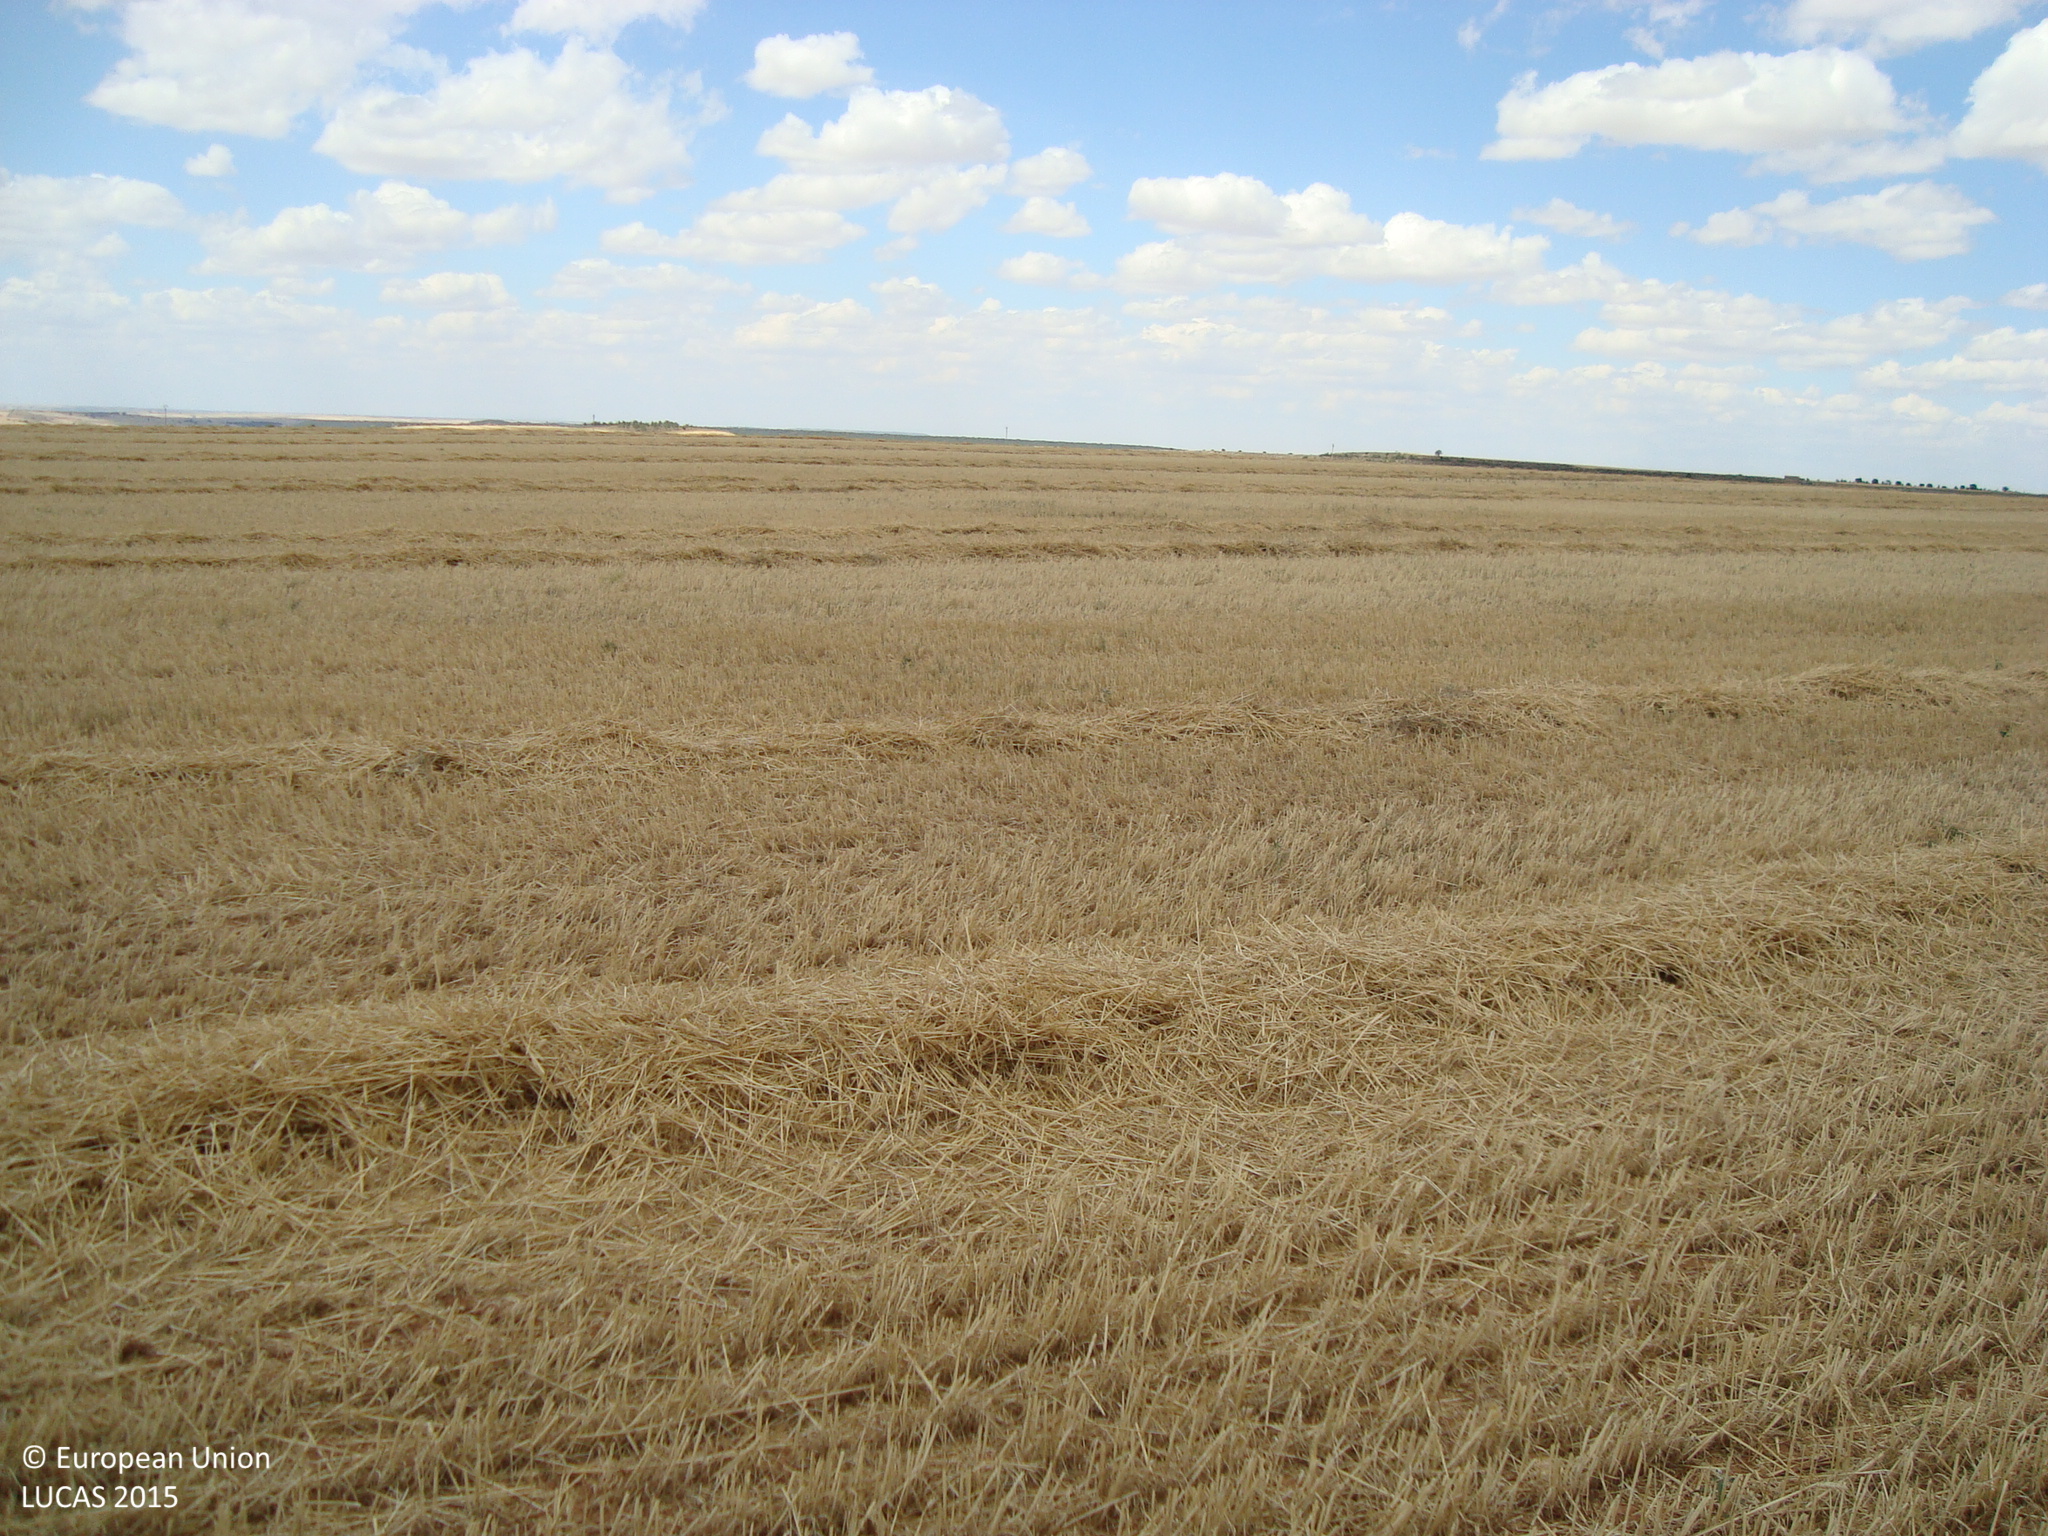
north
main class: Cropland
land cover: Common wheat
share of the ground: > 75 %
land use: Agriculture (excluding fallow land and kitchen gardens)
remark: Harvested field
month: July
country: ES
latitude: 41.9749
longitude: -3.8280
